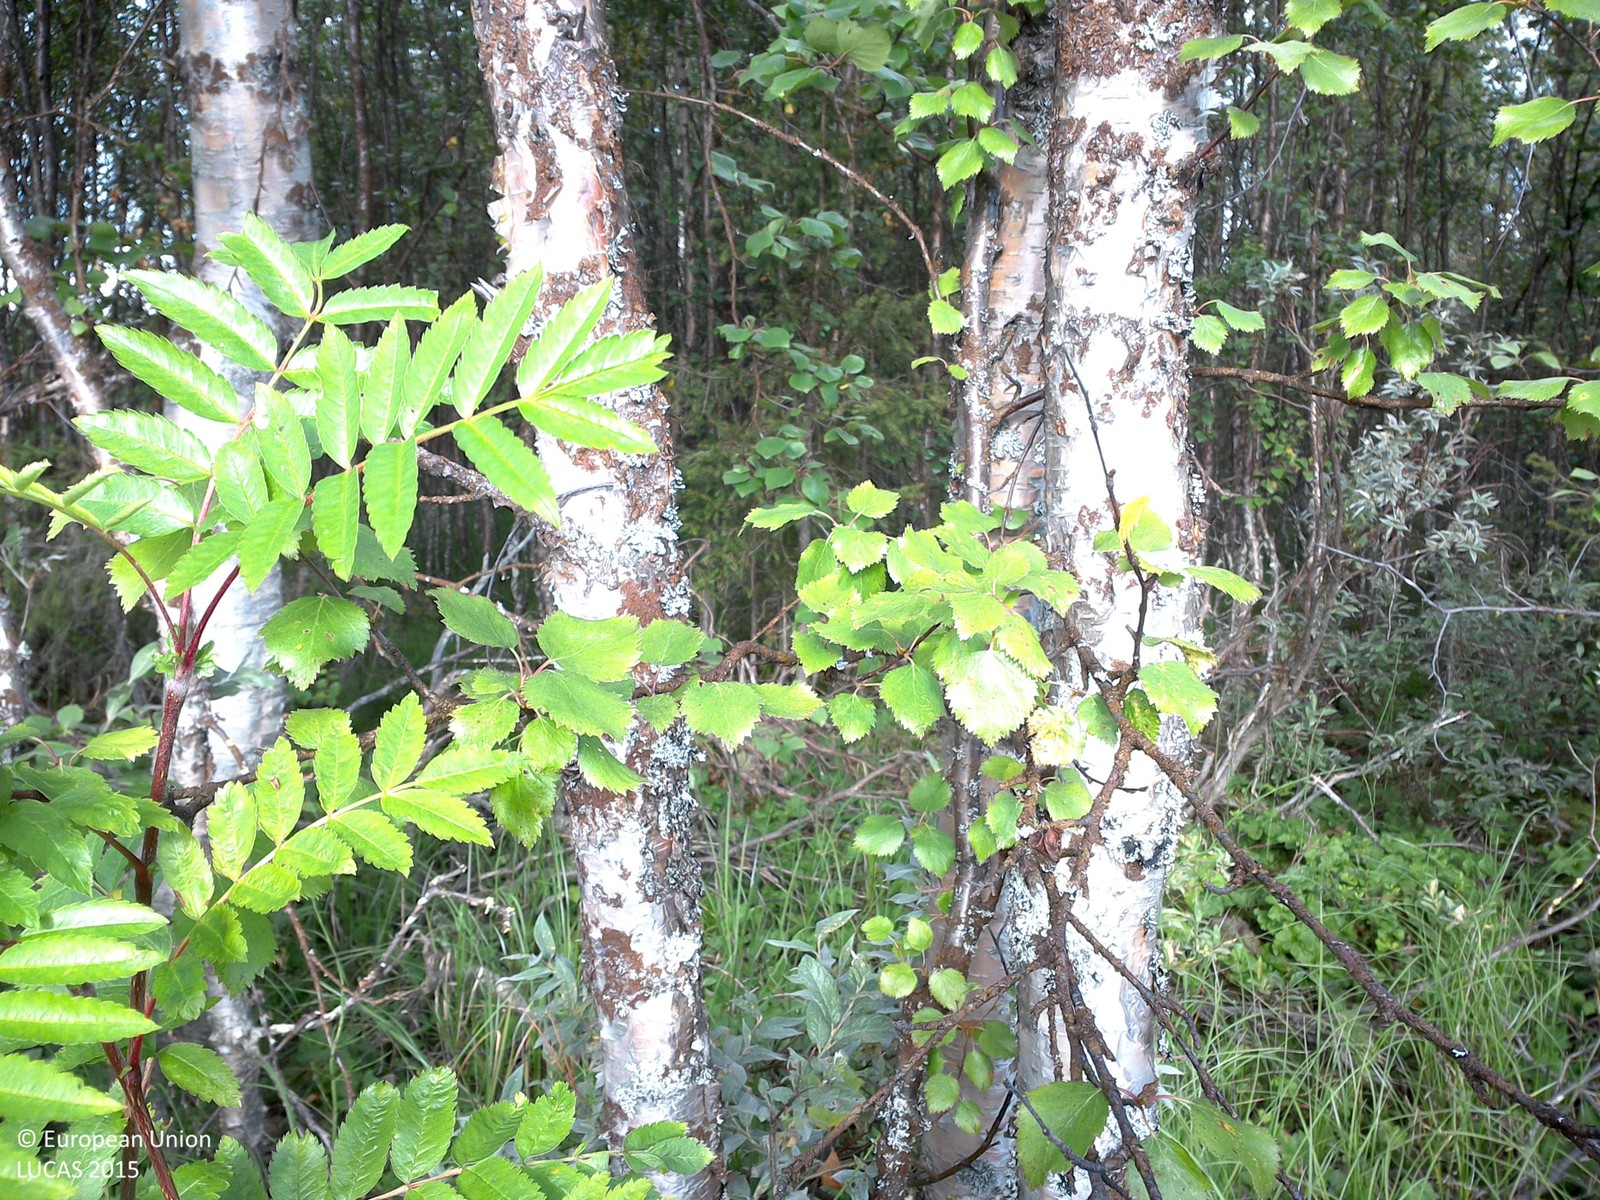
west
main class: Woodland
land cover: Broadleaved woodland
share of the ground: 50 - 75 %
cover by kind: broadleaved forest trees 55 %, shrubs 40 %, herbaceous plants 5 %
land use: Semi-natural and natural areas not in use
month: August
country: SE
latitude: 67.3837
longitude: 21.8144
